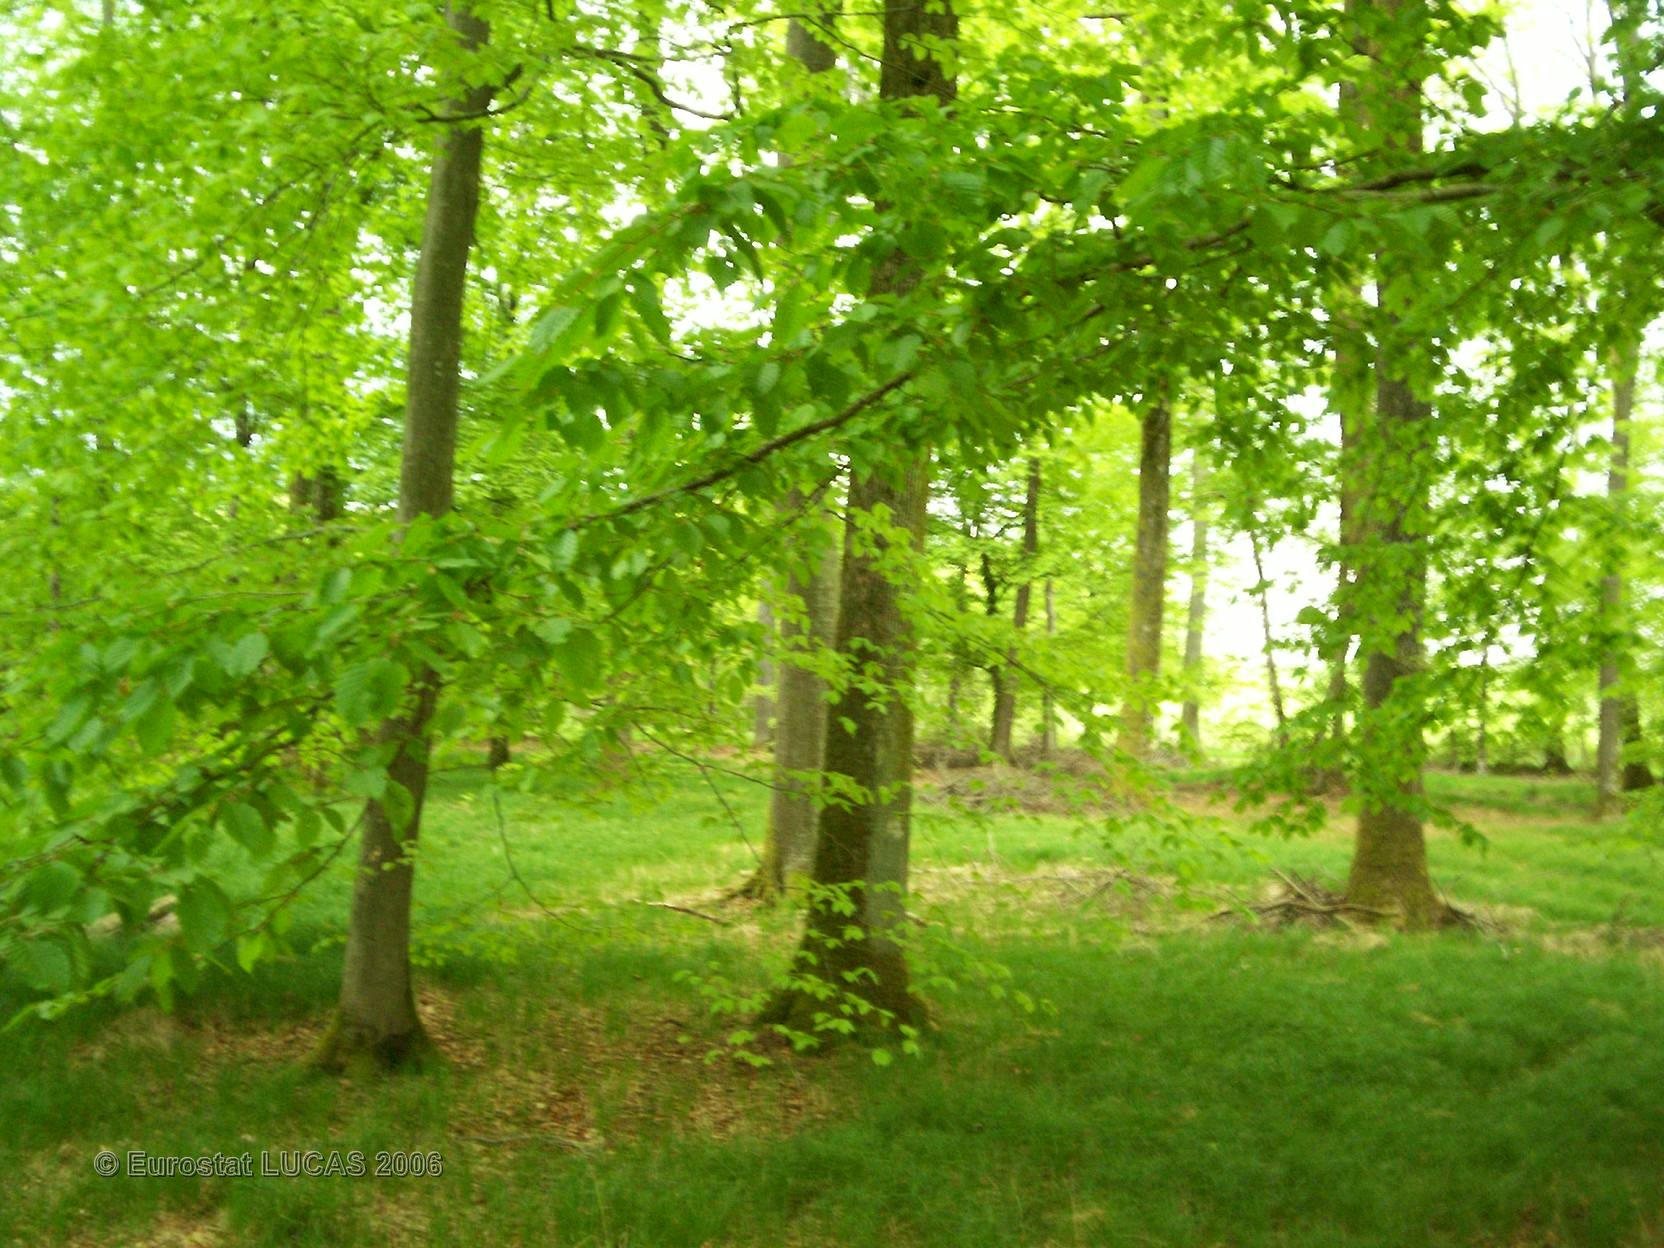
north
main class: Woodland
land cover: Broadleaved forest
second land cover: Grassland with sparse tree/shrub cover
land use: Forestry
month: May
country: FR
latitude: 47.7354
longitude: 7.1078
